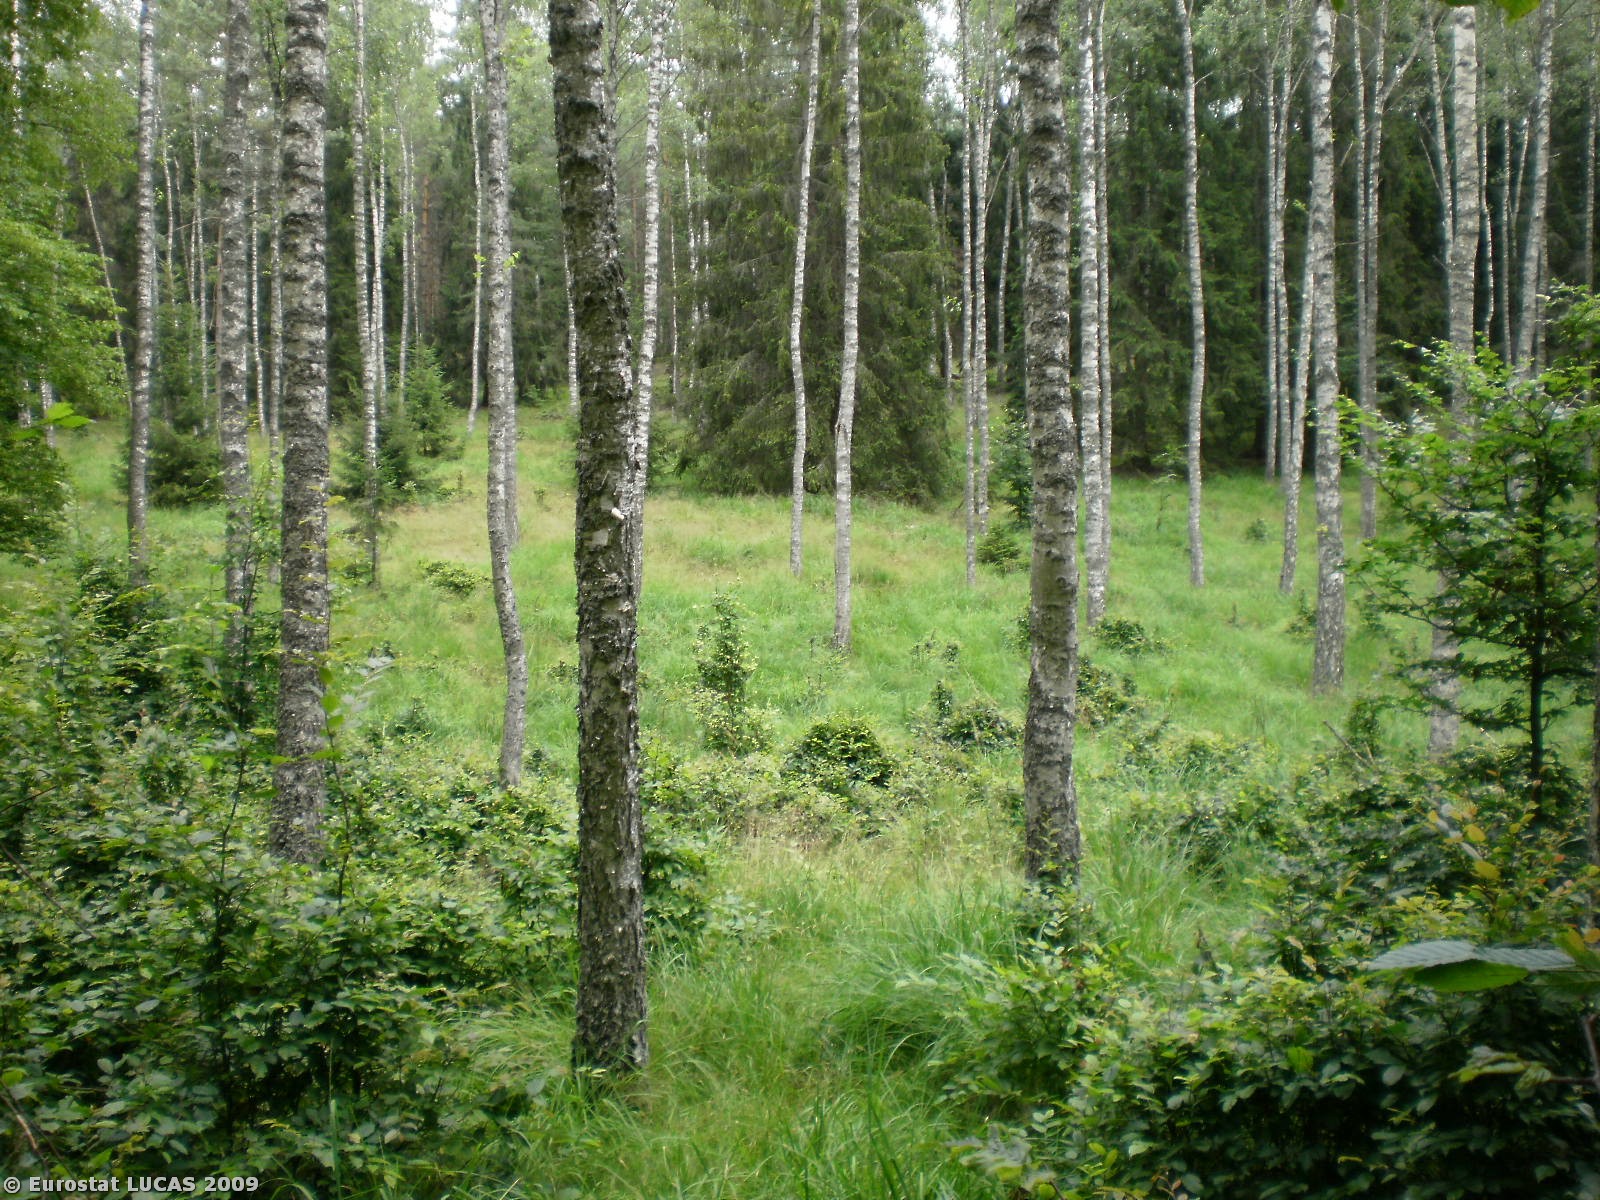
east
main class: Woodland
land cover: Broadleaved woodland
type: mesophytic deciduous forest
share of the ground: > 75 %
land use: Forestry
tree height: > 5 m
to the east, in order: Broadleaved woodland; Mixed woodland; Tracks; Coniferous woodland; Mixed woodland
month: July
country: PL
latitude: 53.7890
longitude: 19.9426
